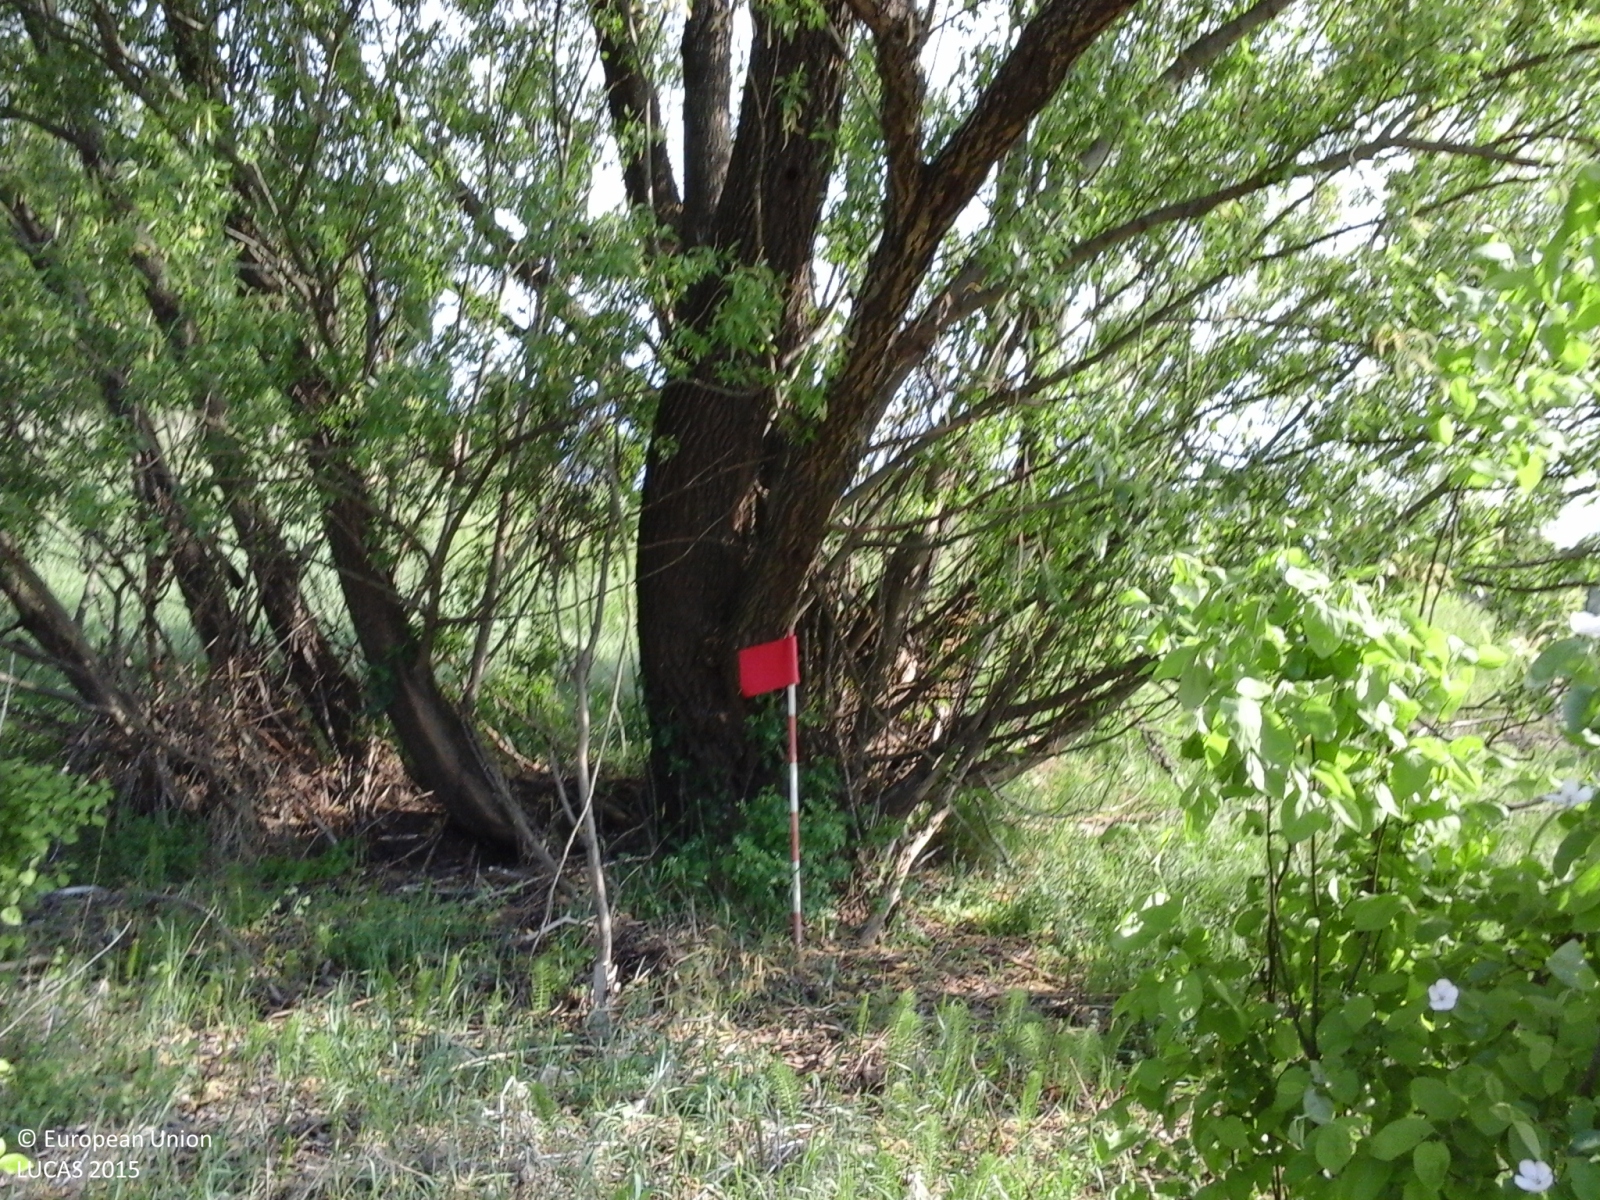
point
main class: Woodland
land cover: Broadleaved woodland
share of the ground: > 75 %
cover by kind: herbaceous plants 70 %, broadleaved forest trees 30 %
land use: Semi-natural and natural areas not in use
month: April
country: IT
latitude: 44.9979
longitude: 9.3796
